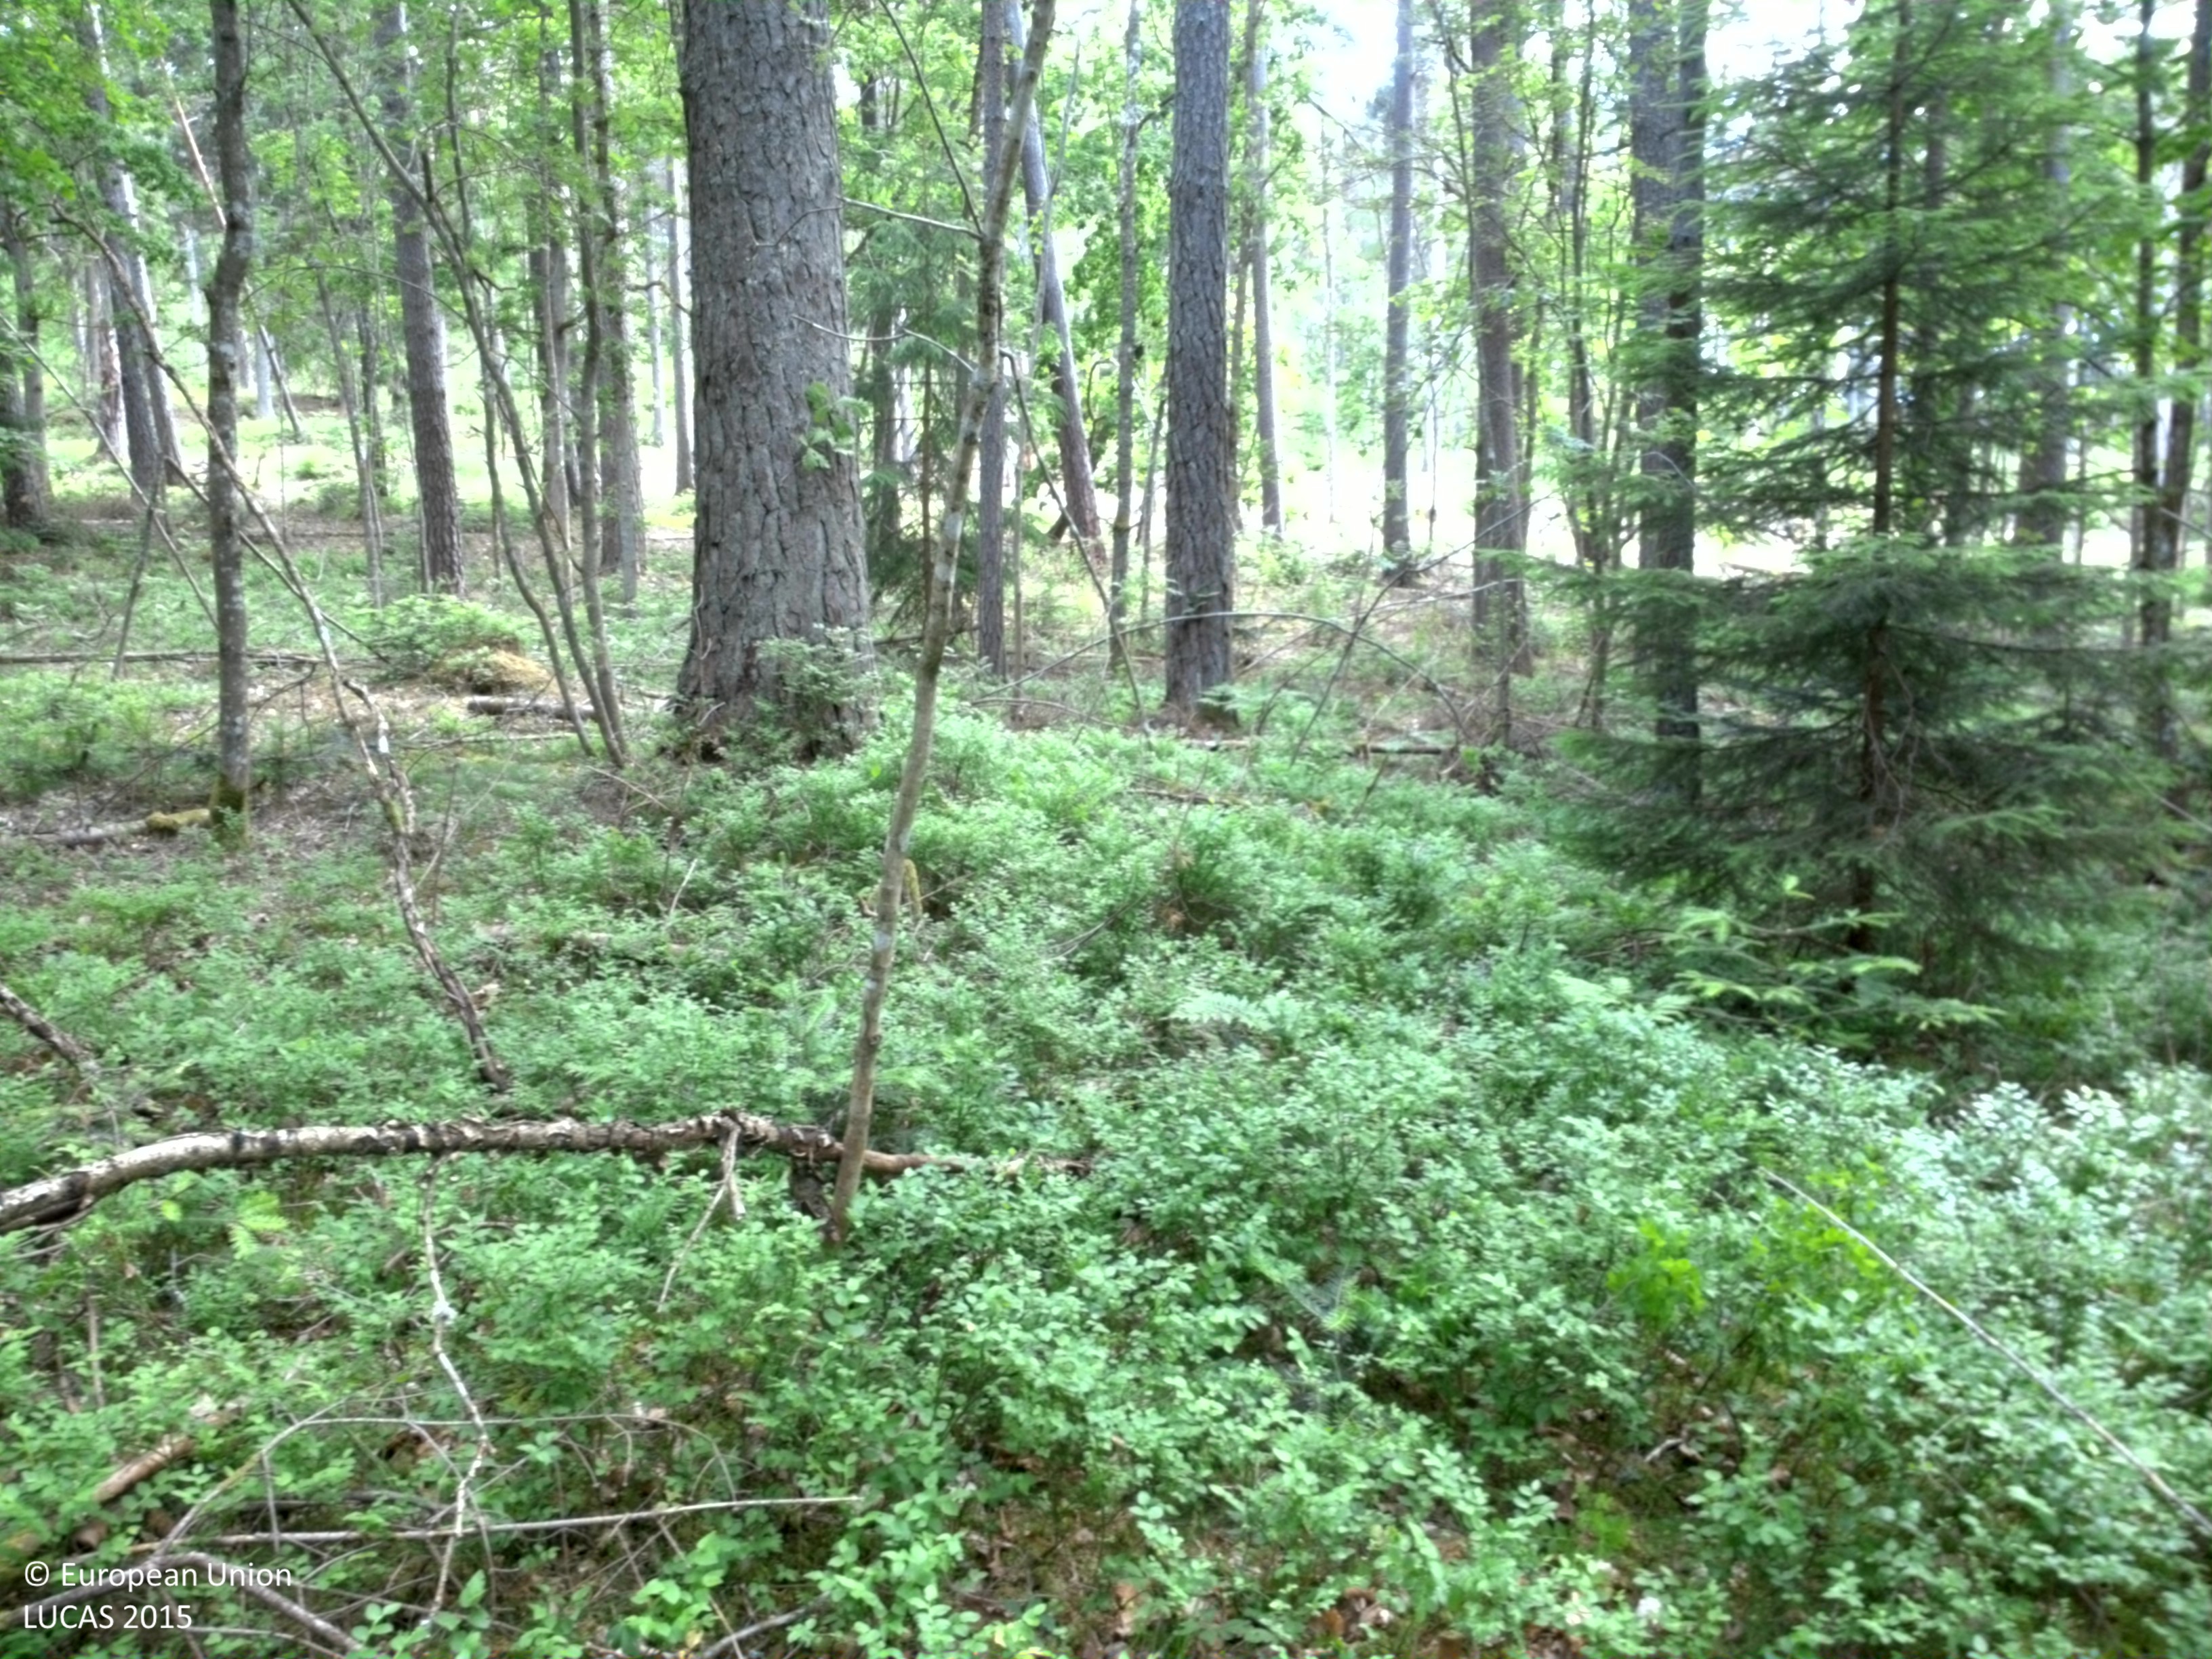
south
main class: Woodland
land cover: Pine dominated mixed woodland
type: boreal forest
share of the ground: 25 - 50 %
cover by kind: herbaceous plants 45 %, coniferous forest trees 25 %, broadleaved forest trees 20 %, lichens and mosses 10 %
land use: Amenities, museums, leisure
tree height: > 5 m
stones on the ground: < 10 %
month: June
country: SE
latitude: 58.4858
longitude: 16.3249
